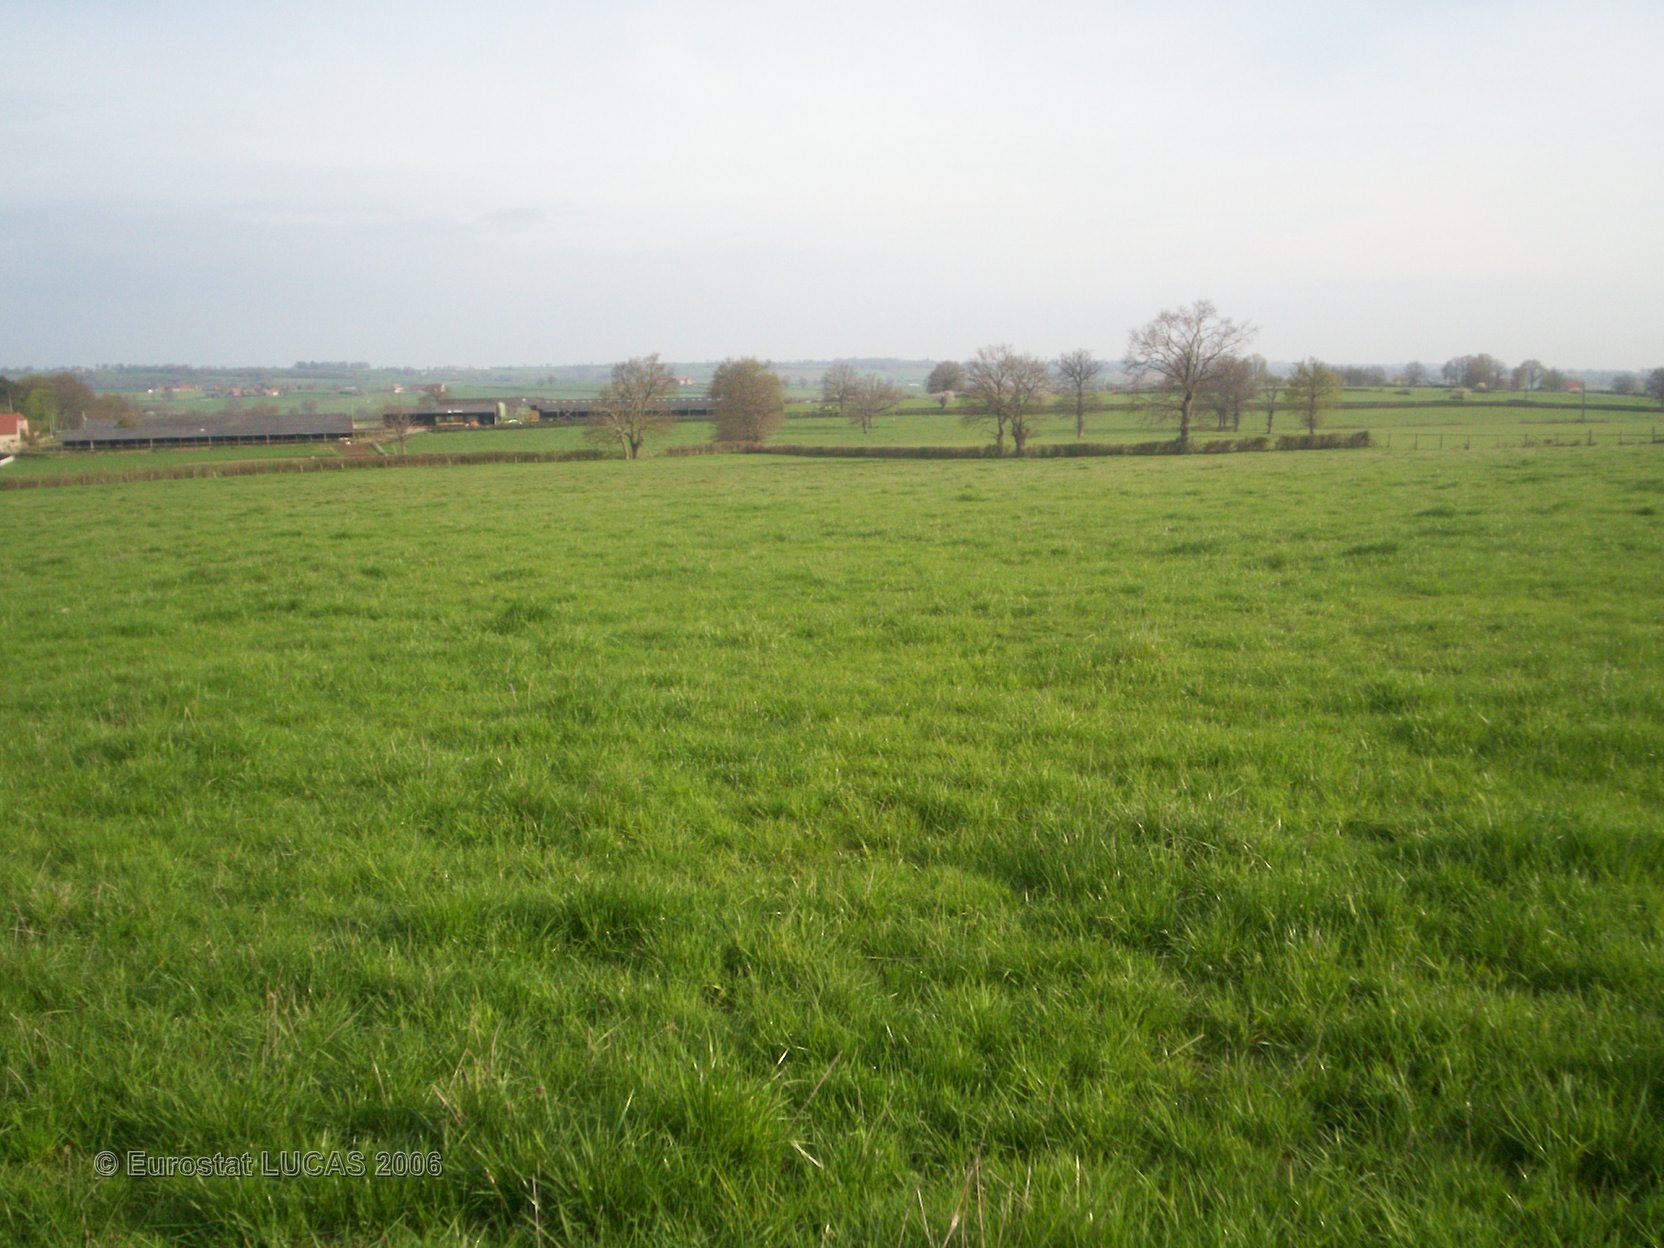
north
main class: Grassland
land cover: Grassland without tree/shrub cover
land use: Agriculture (excluding fallow land and kitchen gardens)
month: April
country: FR
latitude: 46.5764
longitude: 3.0422
